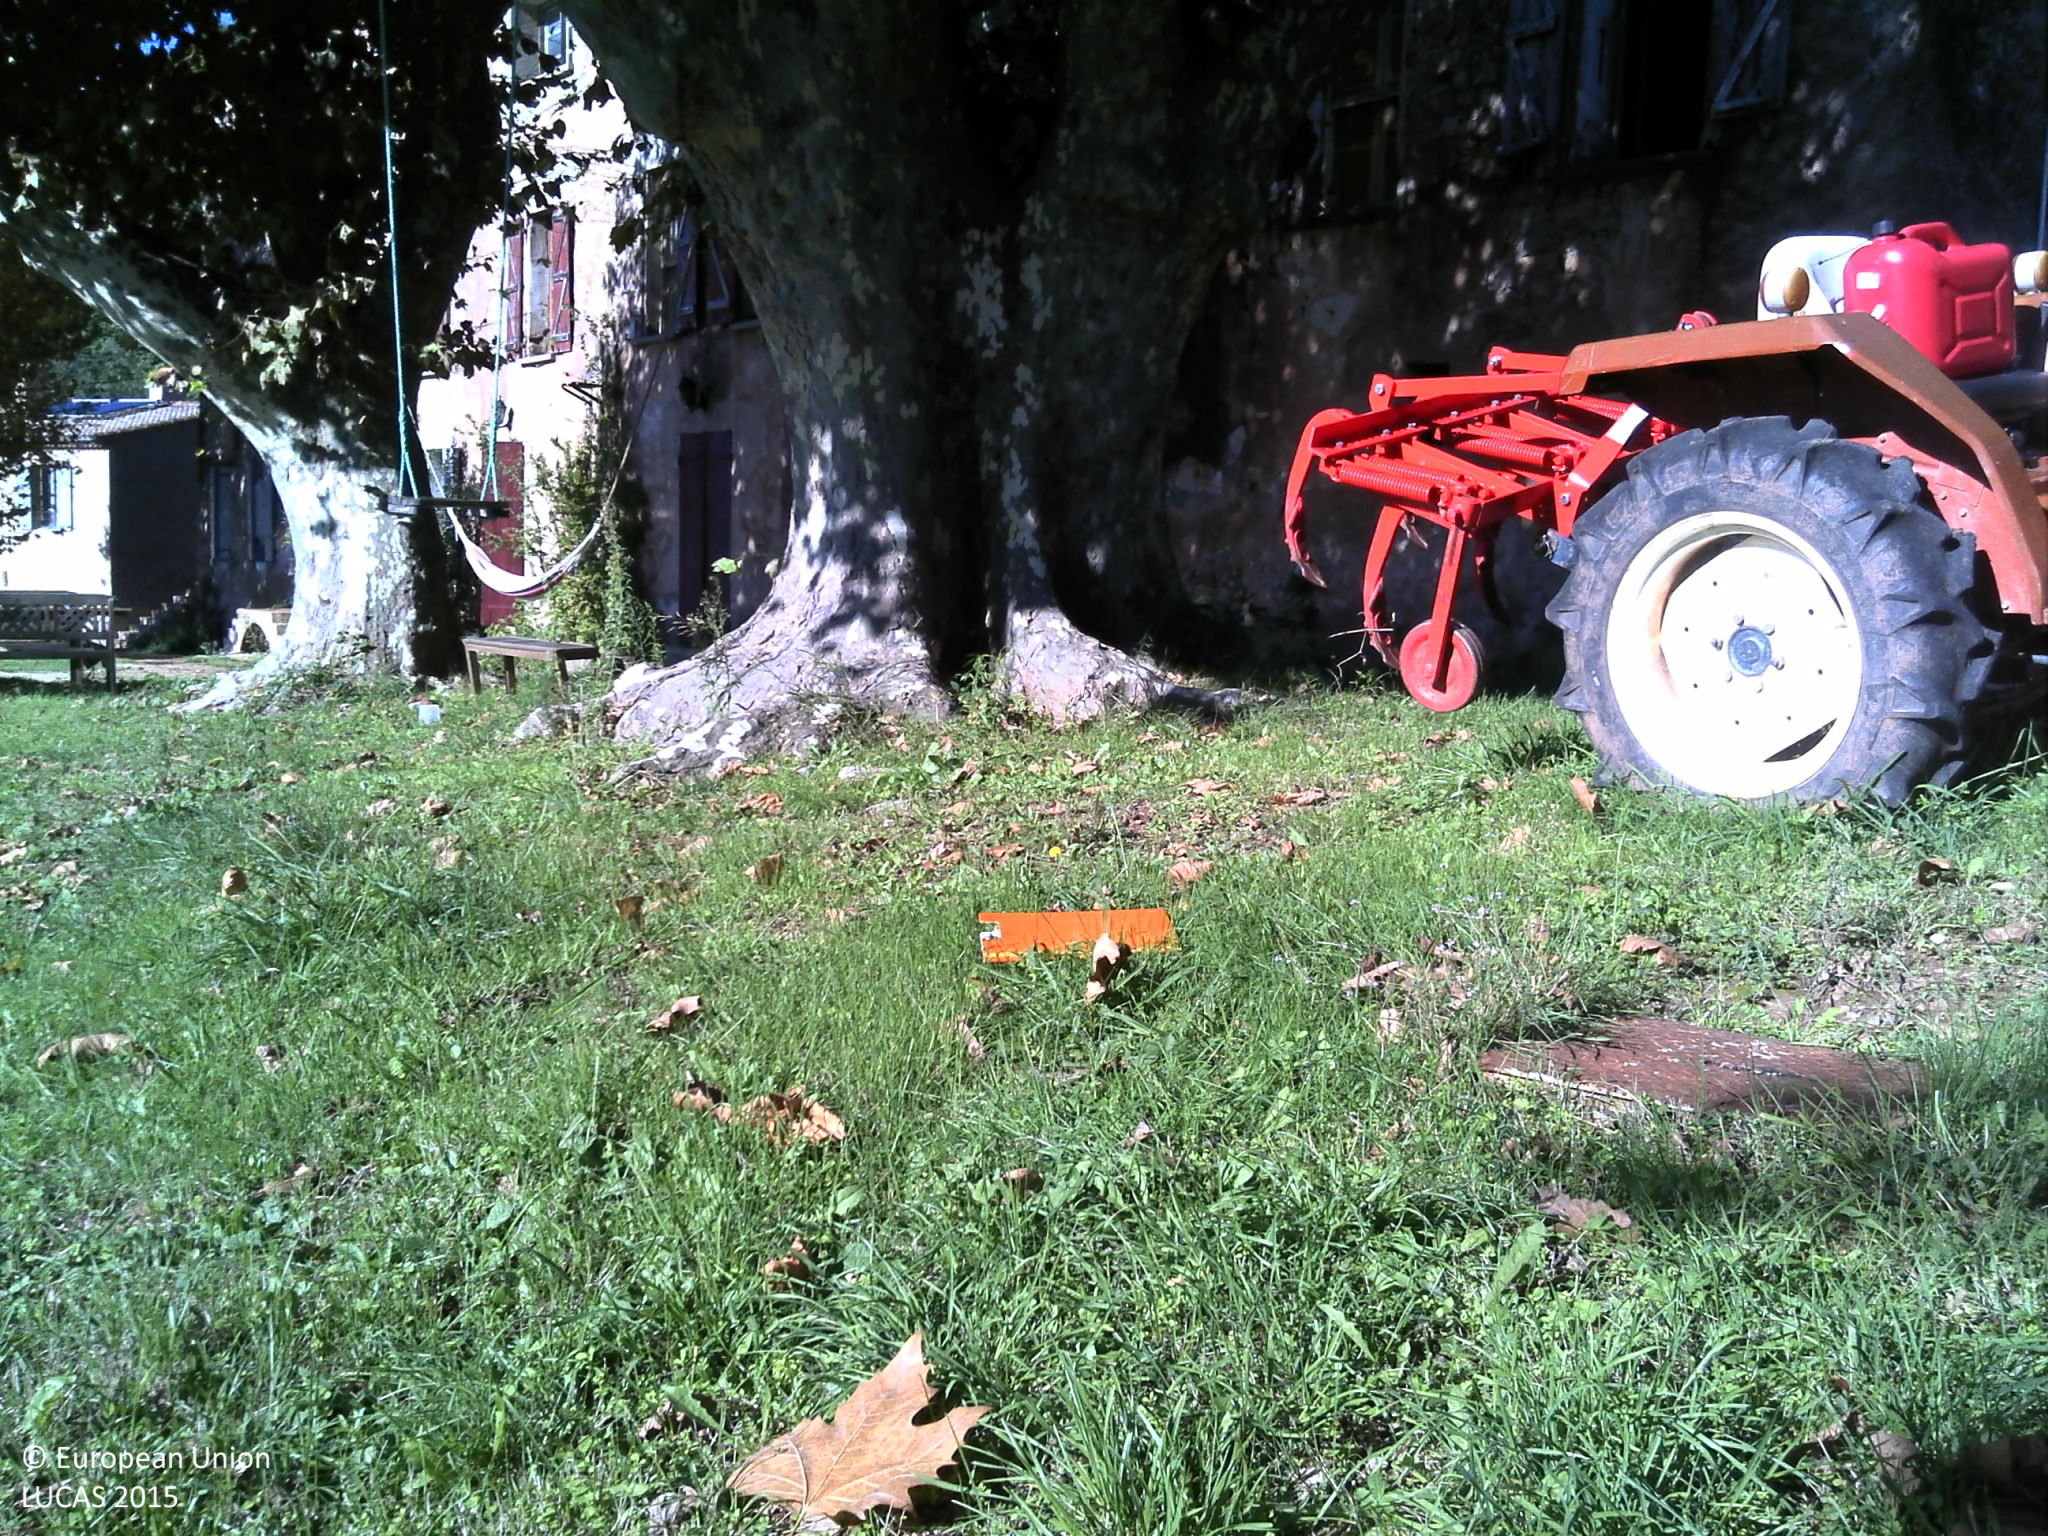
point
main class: Woodland
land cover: Broadleaved woodland
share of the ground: 50 - 75 %
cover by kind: broadleaved forest trees 50 %, herbaceous plants 50 %
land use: Residential
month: October
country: FR
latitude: 43.5170
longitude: 6.5569
